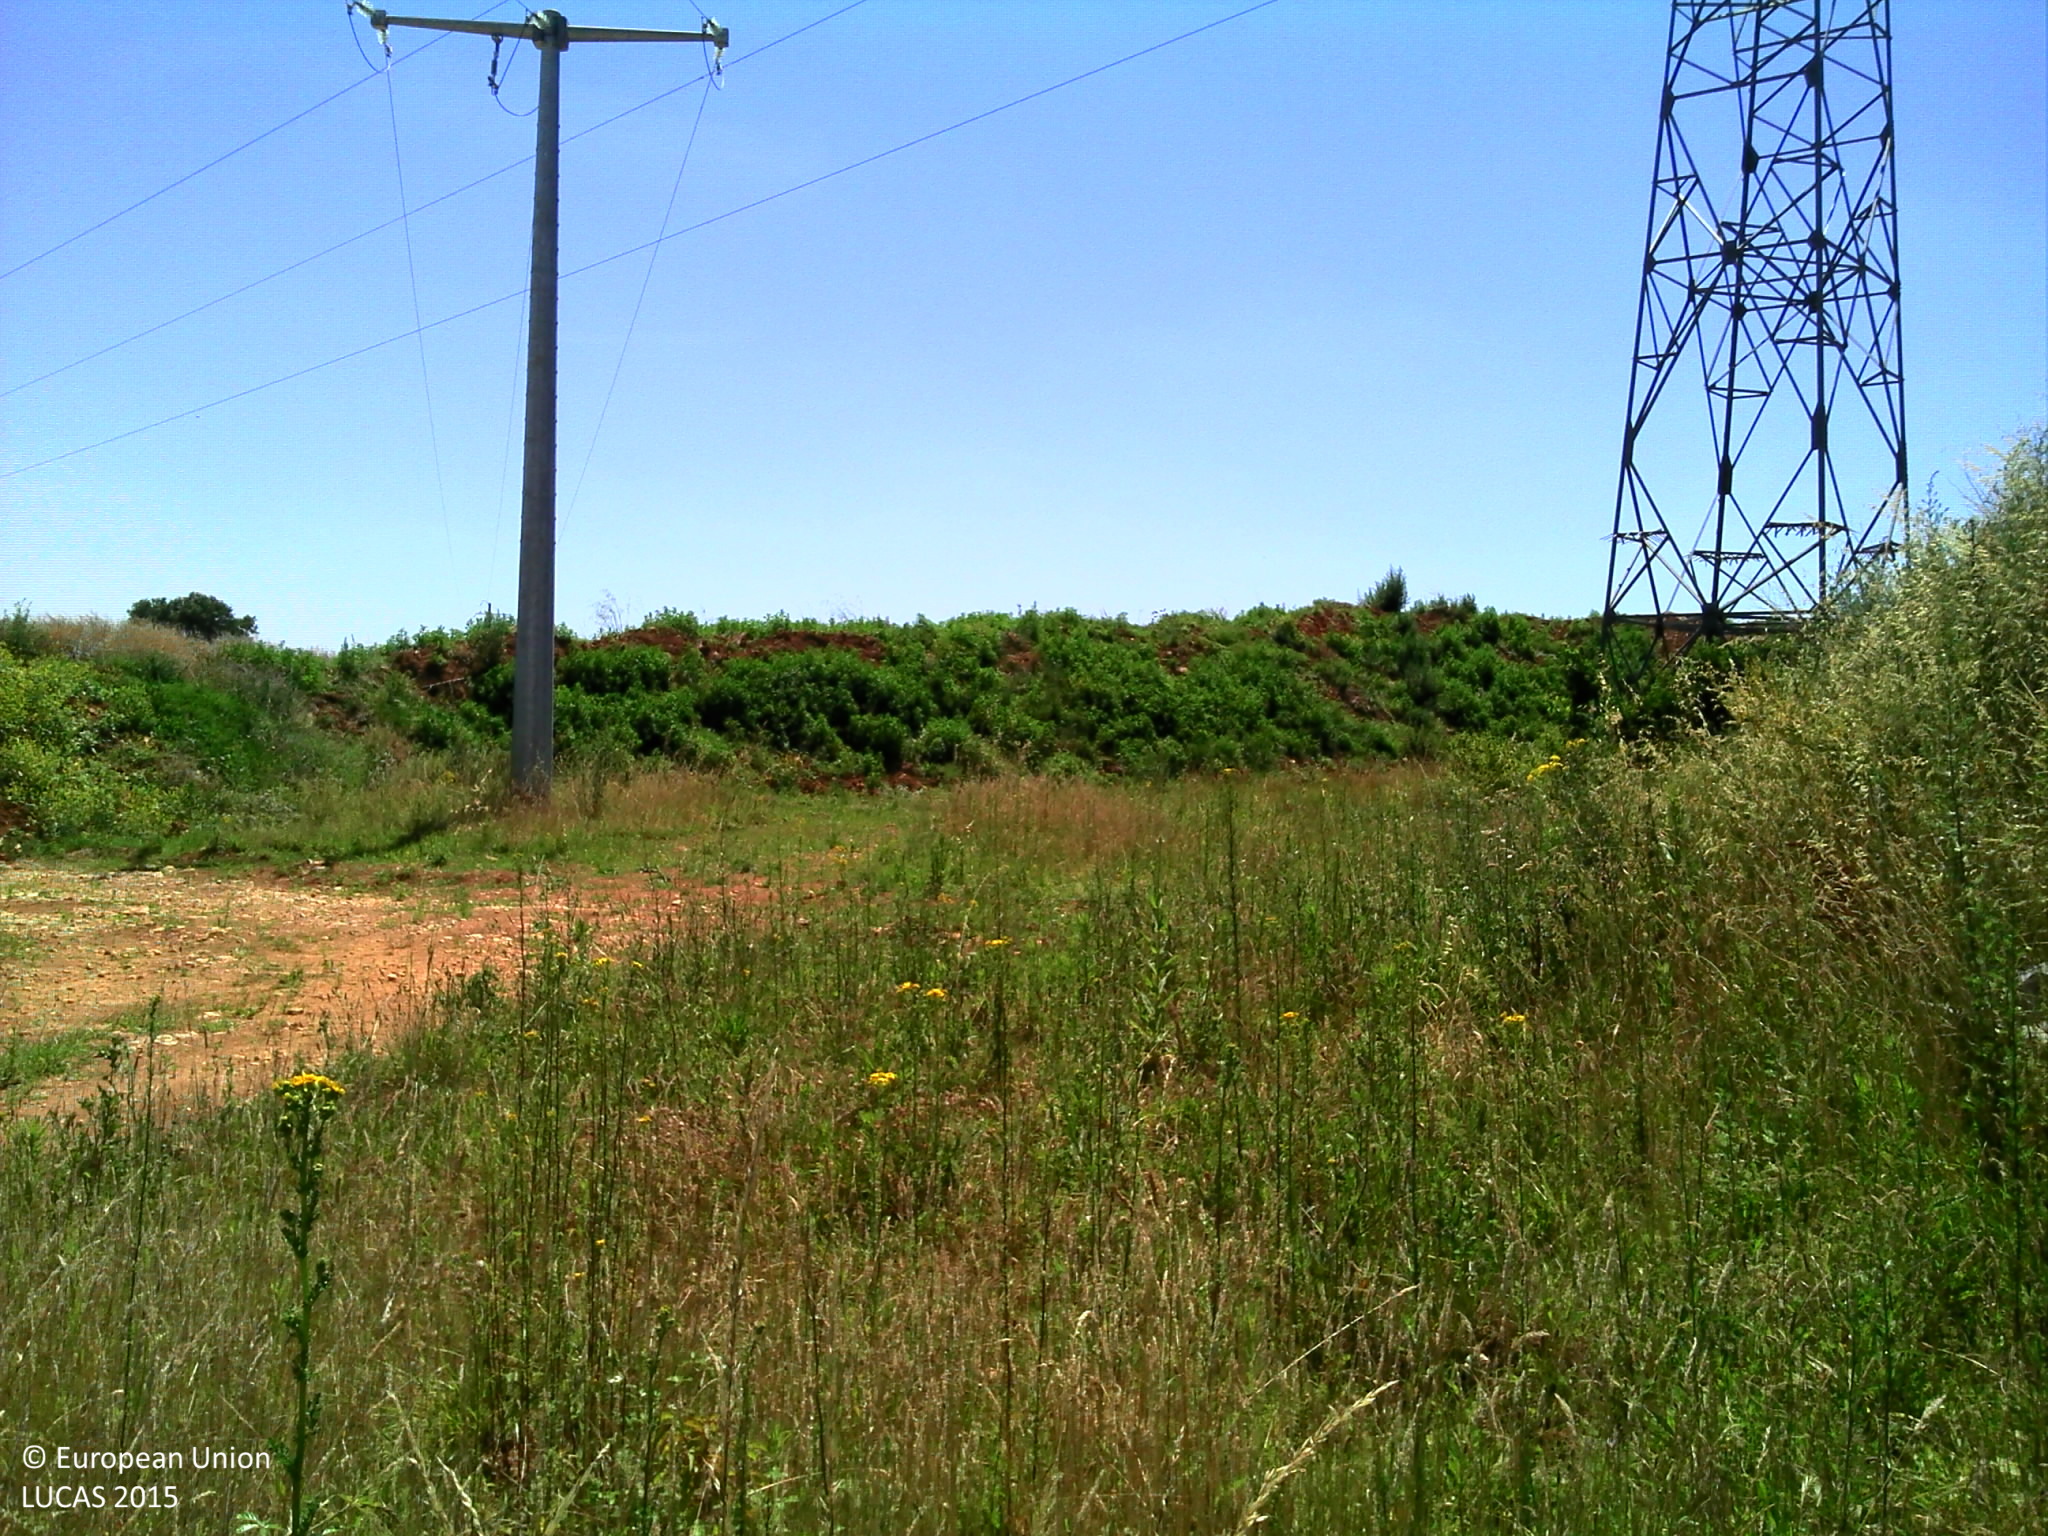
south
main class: Grassland
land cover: Grassland without tree/shrub cover
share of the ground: > 75 %
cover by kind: herbaceous plants 95 %, shrubs 5 %
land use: Mining and quarrying
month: June
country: FR
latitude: 45.8466
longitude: -0.7263
